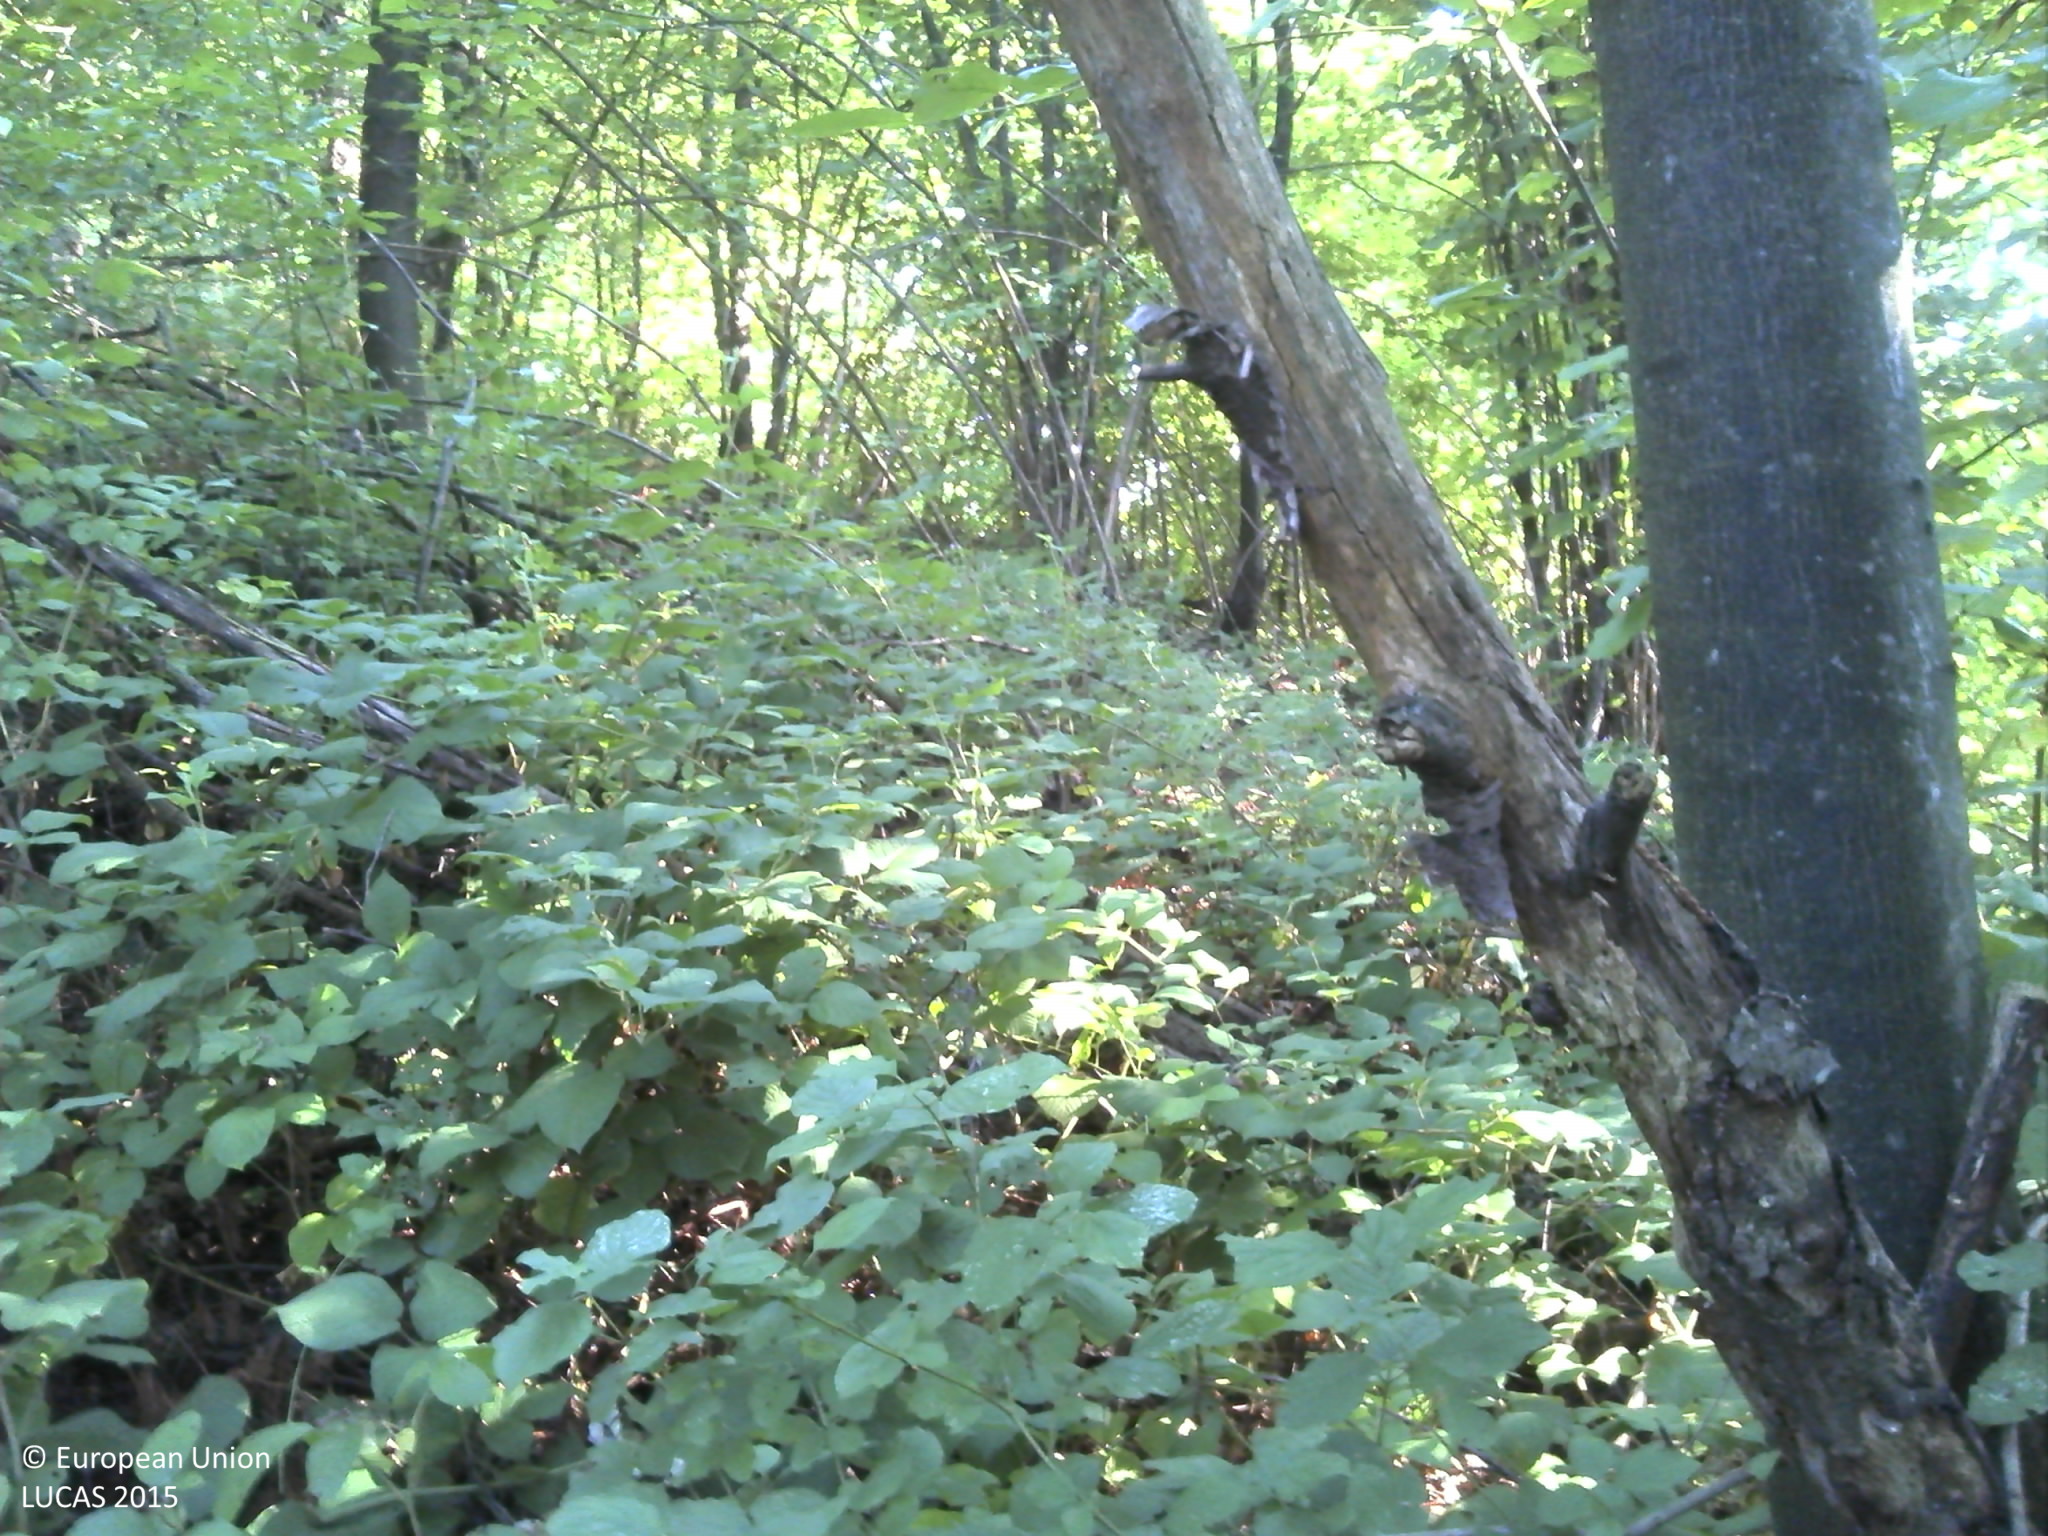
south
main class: Woodland
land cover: Broadleaved woodland
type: acidophilous oak and oak-birch forest
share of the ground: > 75 %
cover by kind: broadleaved forest trees 100 %
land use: Forestry
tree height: > 5 m
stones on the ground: < 10 %
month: August
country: HR
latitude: 45.3709
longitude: 16.2921
